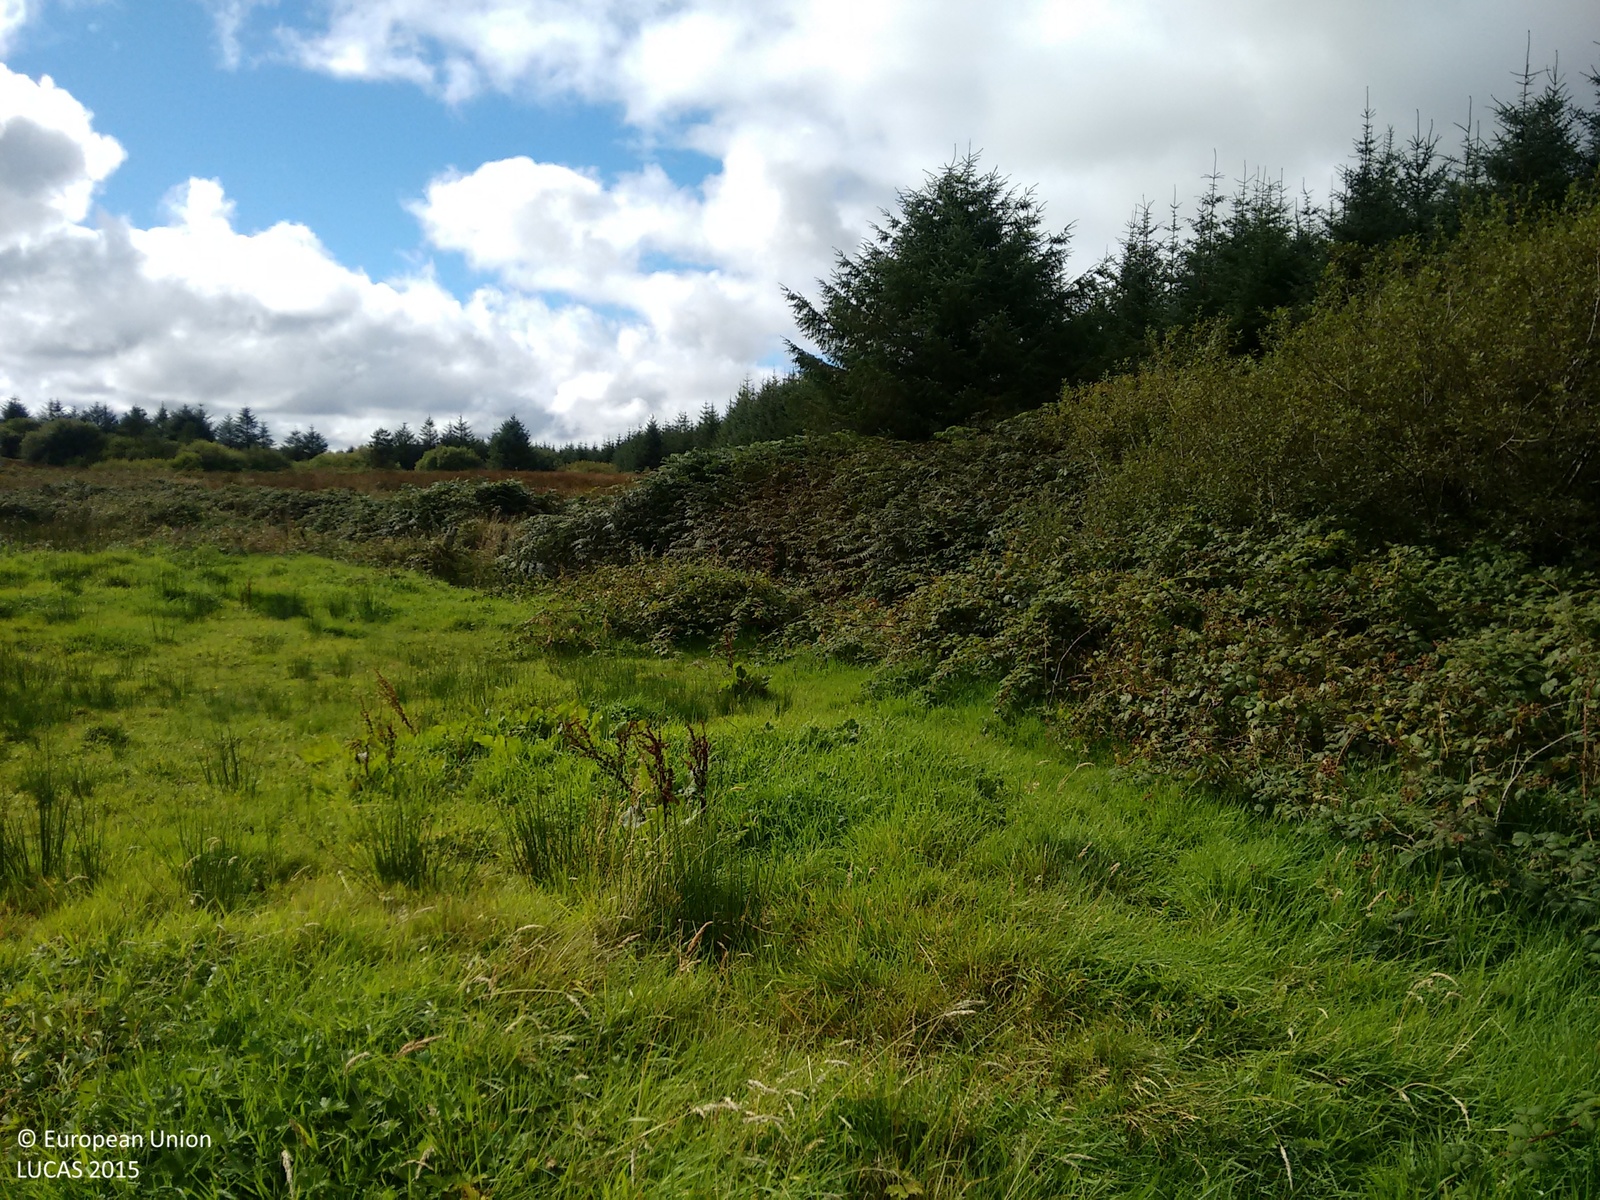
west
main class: Grassland
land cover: Grassland without tree/shrub cover
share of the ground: > 75 %
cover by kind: herbaceous plants 95 %
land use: Agriculture (excluding fallow land and kitchen gardens)
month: September
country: IE
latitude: 52.9201
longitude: -9.1834
